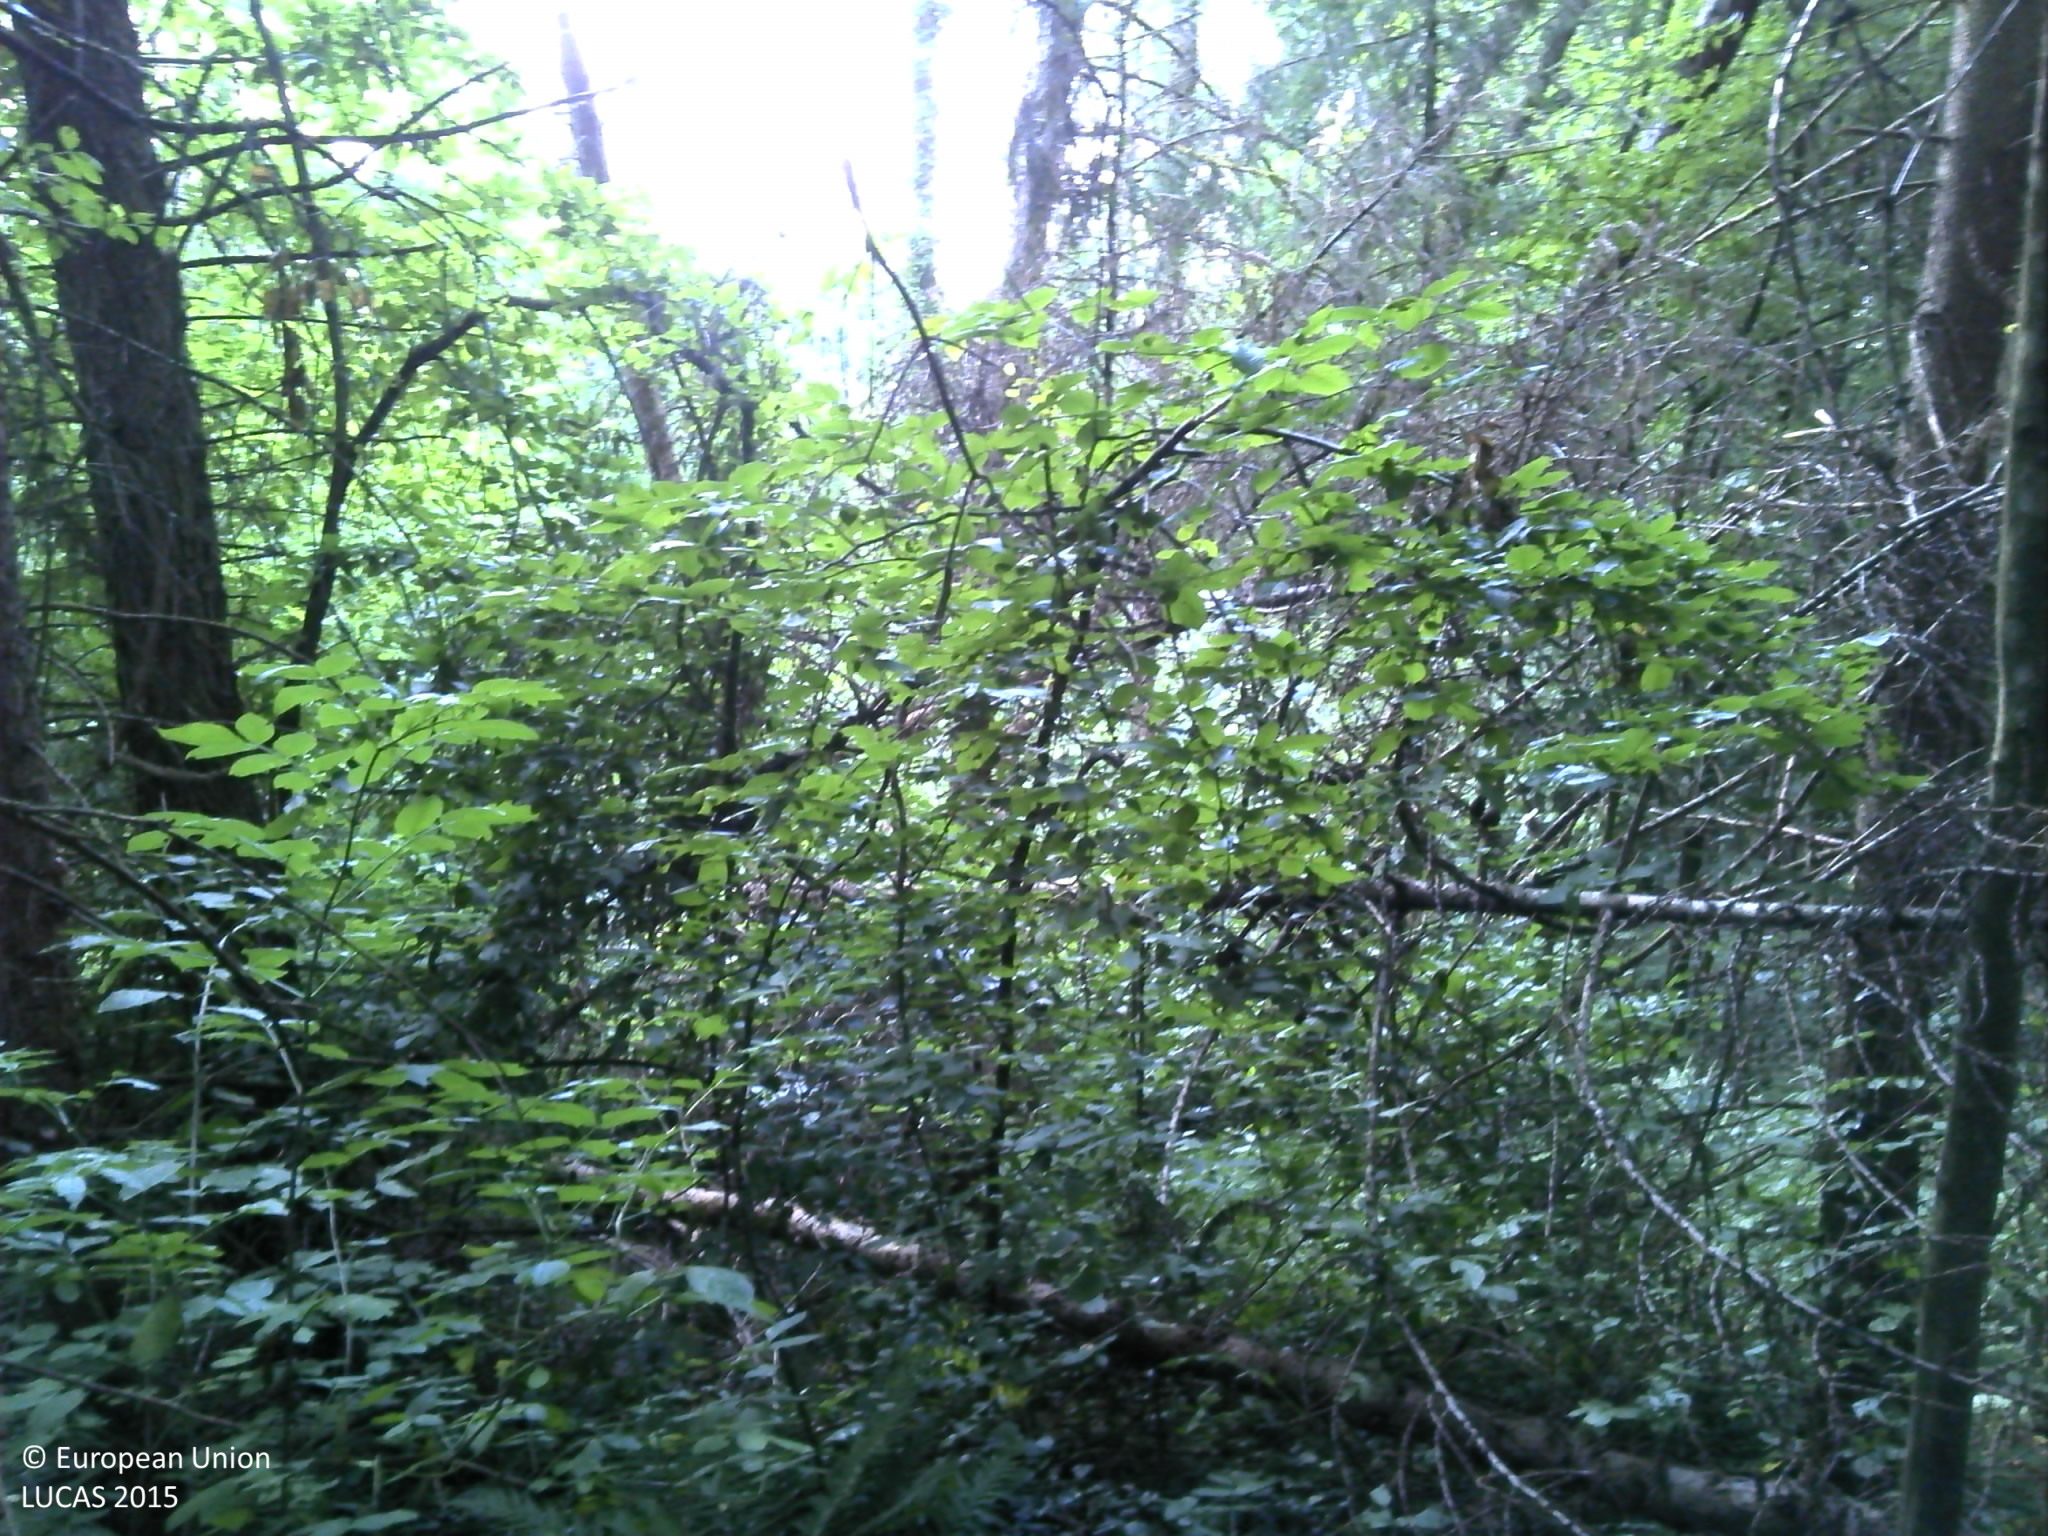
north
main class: Woodland
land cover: Spruce dominated mixed woodland
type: broadleaved evergreen forest
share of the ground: > 75 %
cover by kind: coniferous forest trees 60 %, broadleaved forest trees 20 %, lichens and mosses 20 %
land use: Forestry
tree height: > 5 m
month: July
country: HR
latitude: 45.5806
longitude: 16.7018
